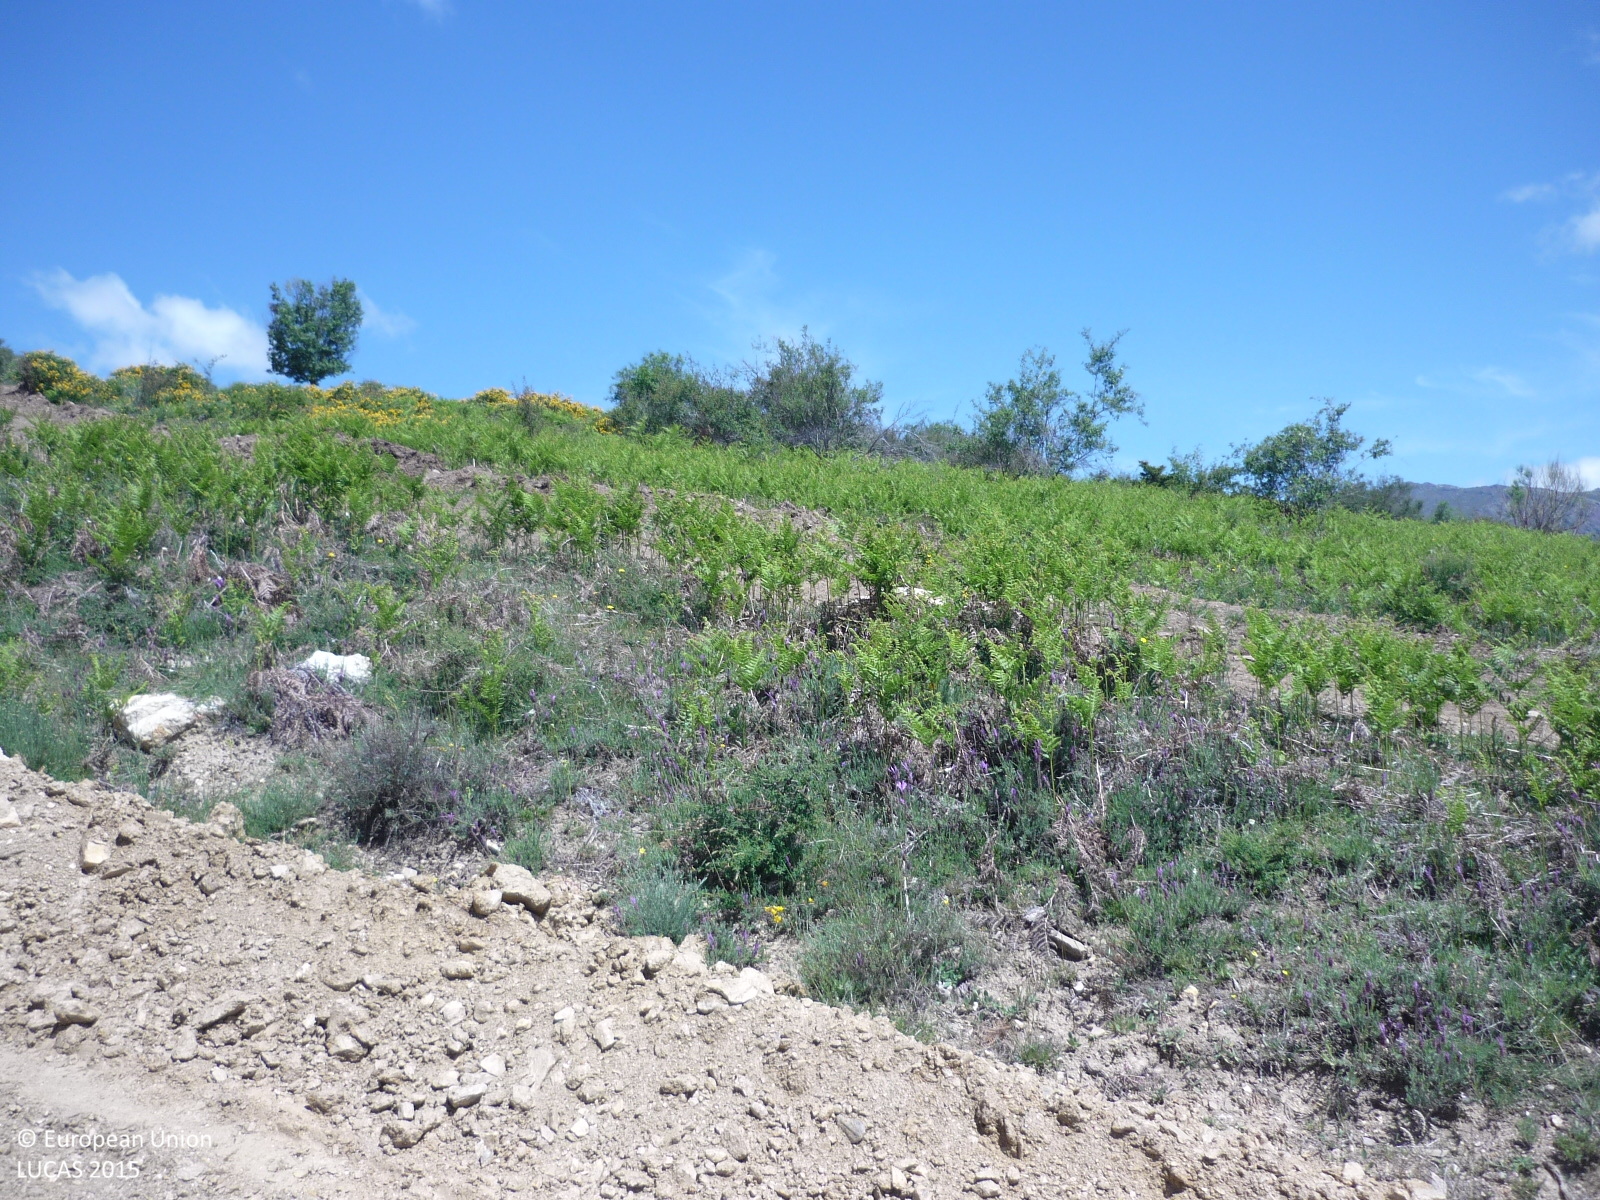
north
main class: Grassland
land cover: Grassland without tree/shrub cover
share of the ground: > 75 %
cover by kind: herbaceous plants 90 %, unconsolidated bare surface 10 %
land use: Agriculture (excluding fallow land and kitchen gardens)
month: May
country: ES
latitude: 41.1007
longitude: -3.5340
